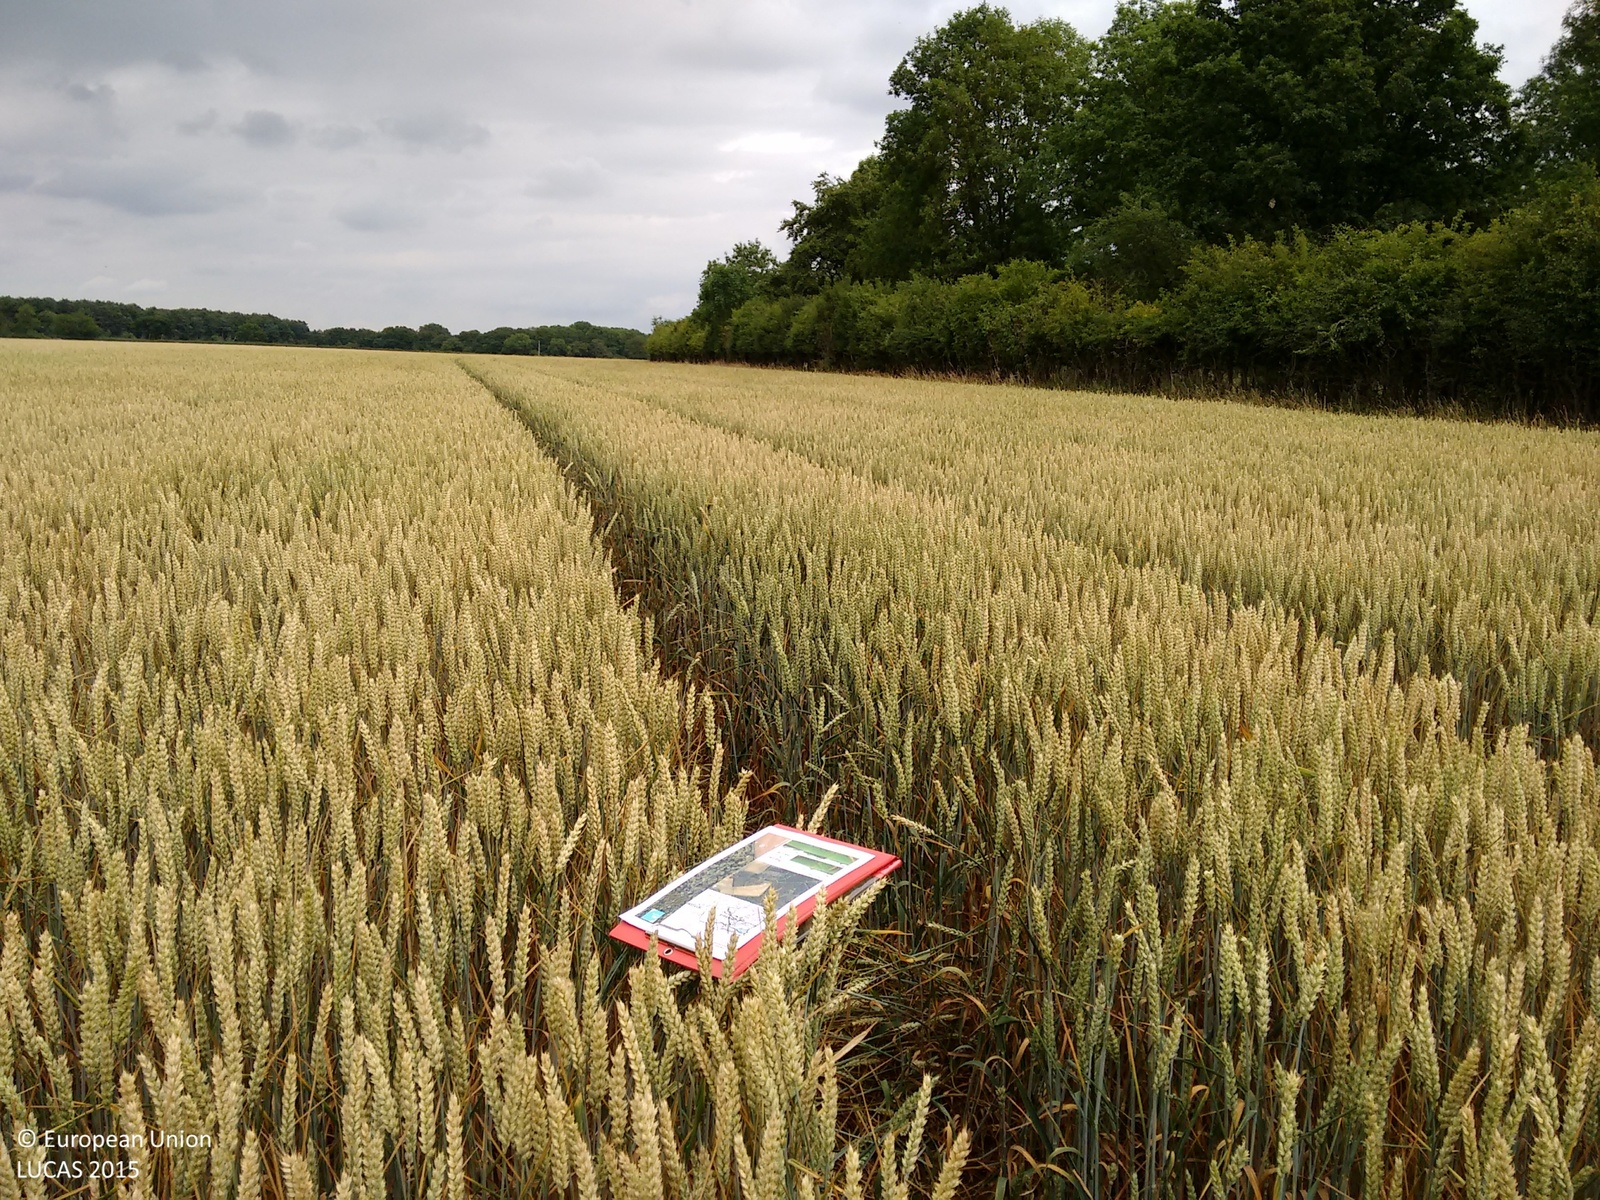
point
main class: Cropland
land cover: Common wheat
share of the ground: > 75 %
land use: Agriculture (excluding fallow land and kitchen gardens)
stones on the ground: 25 - 50 %
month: July
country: GB
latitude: 52.5787
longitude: -0.5308
